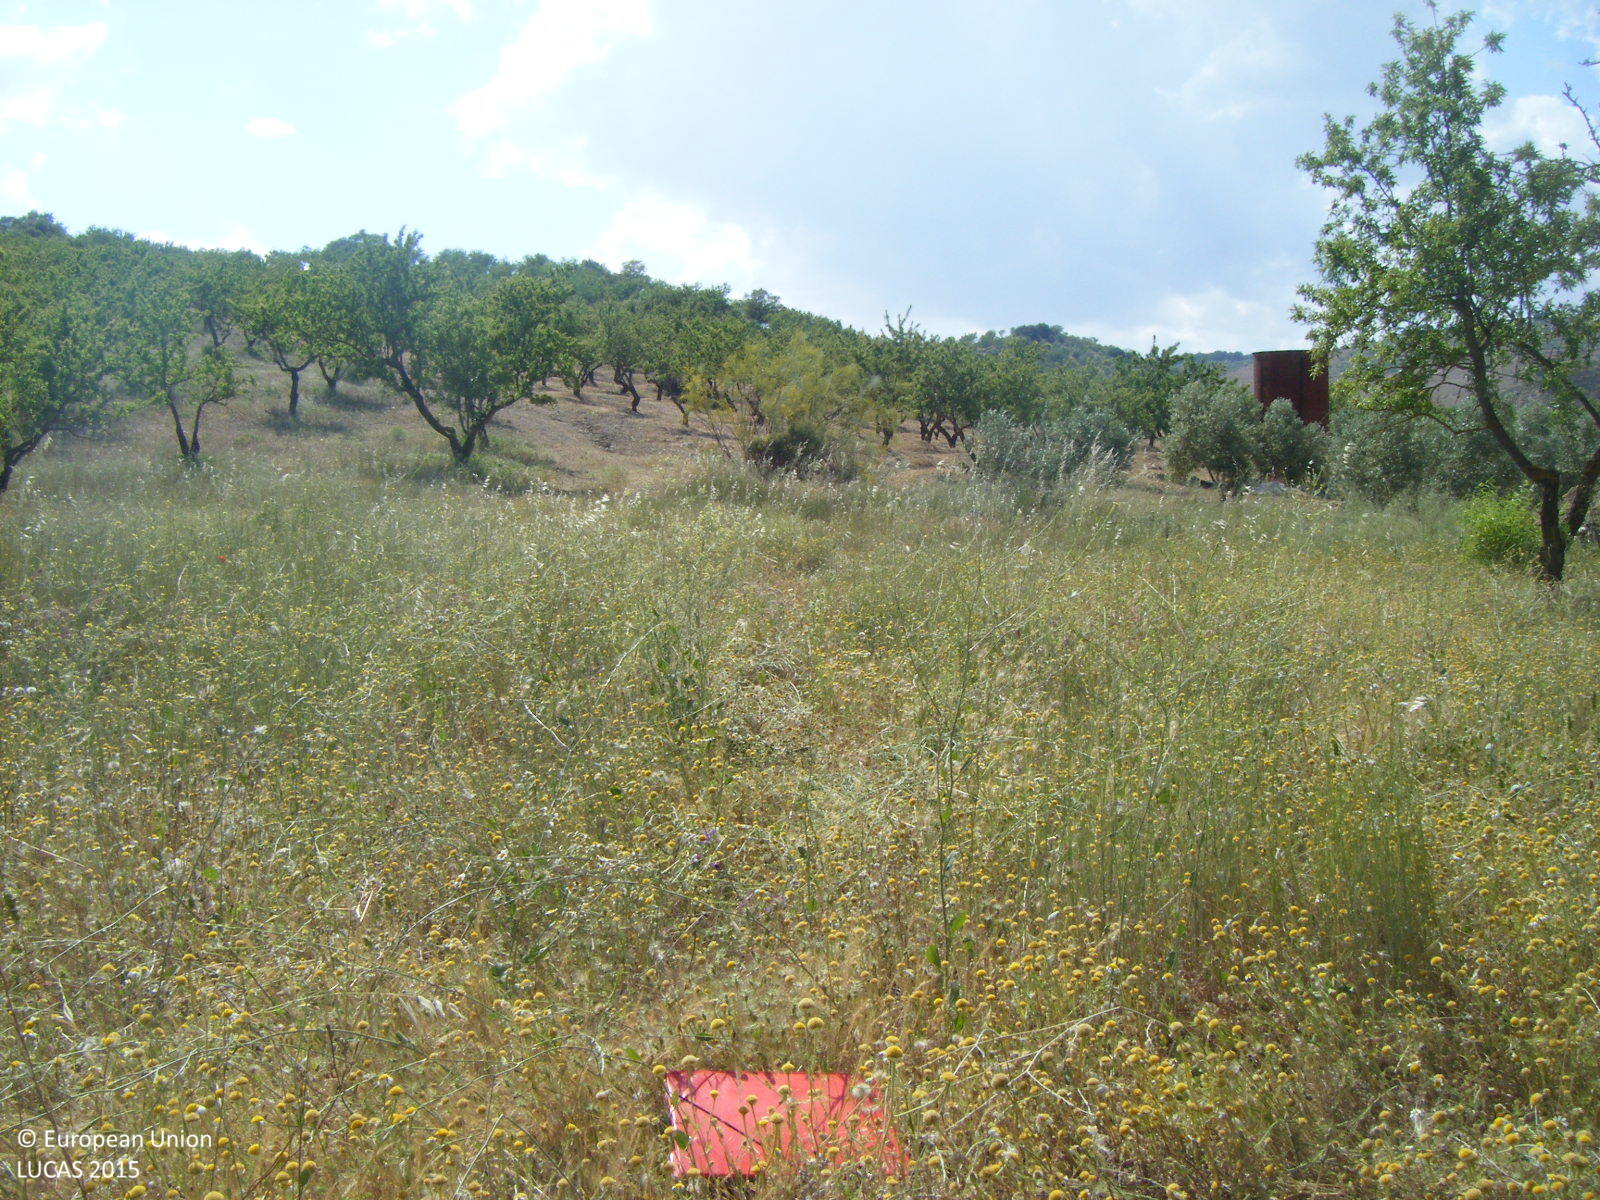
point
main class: Cropland
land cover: Nuts trees
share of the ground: 10 - 25 %
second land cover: Spontaneously vegetated surfaces
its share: > 75 %
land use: Agriculture (excluding fallow land and kitchen gardens)
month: May
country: ES
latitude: 37.0534
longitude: -4.3774
